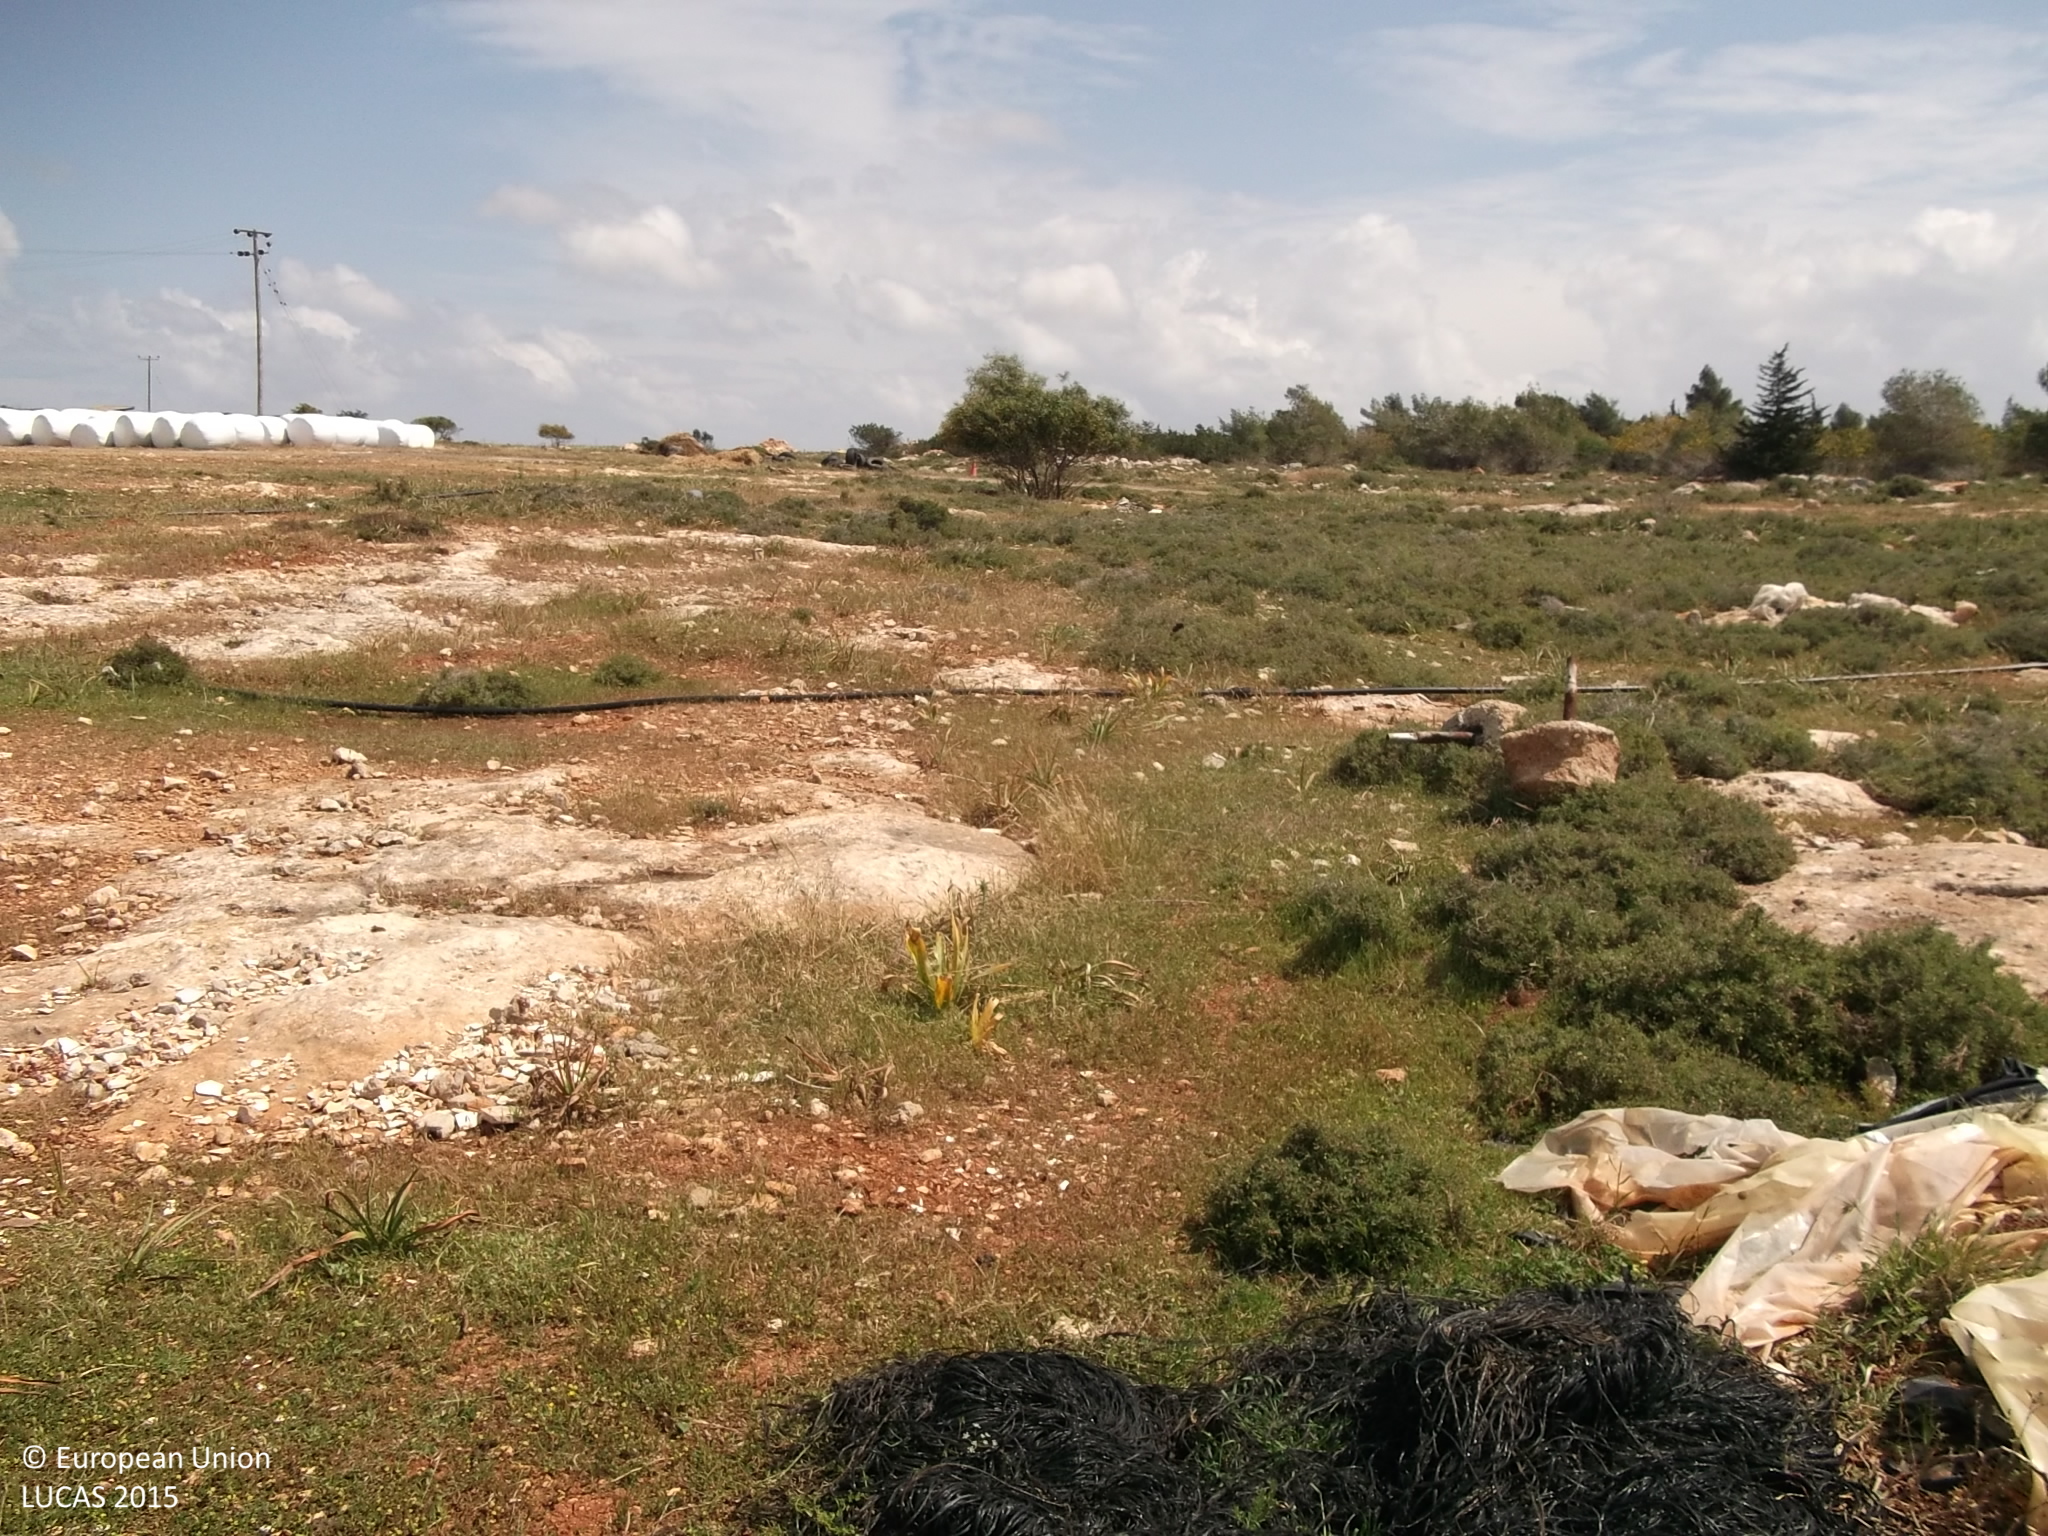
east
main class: Shrubland
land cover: Shrubland without tree cover
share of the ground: 50 - 75 %
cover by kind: shrubs 50 %, herbaceous plants 30 %, consolidated bare surface 10 %, unconsolidated bare surface 10 %
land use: Agriculture (excluding fallow land and kitchen gardens)
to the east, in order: Shrubland without tree cover; Tracks; Rock outcrops; Shrubland without tree cover; Other coniferous woodland; Tracks; Grassland with sparse tree/shrub cover; Other mixed woodland
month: March
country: CY
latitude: 35.0125
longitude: 33.9608
